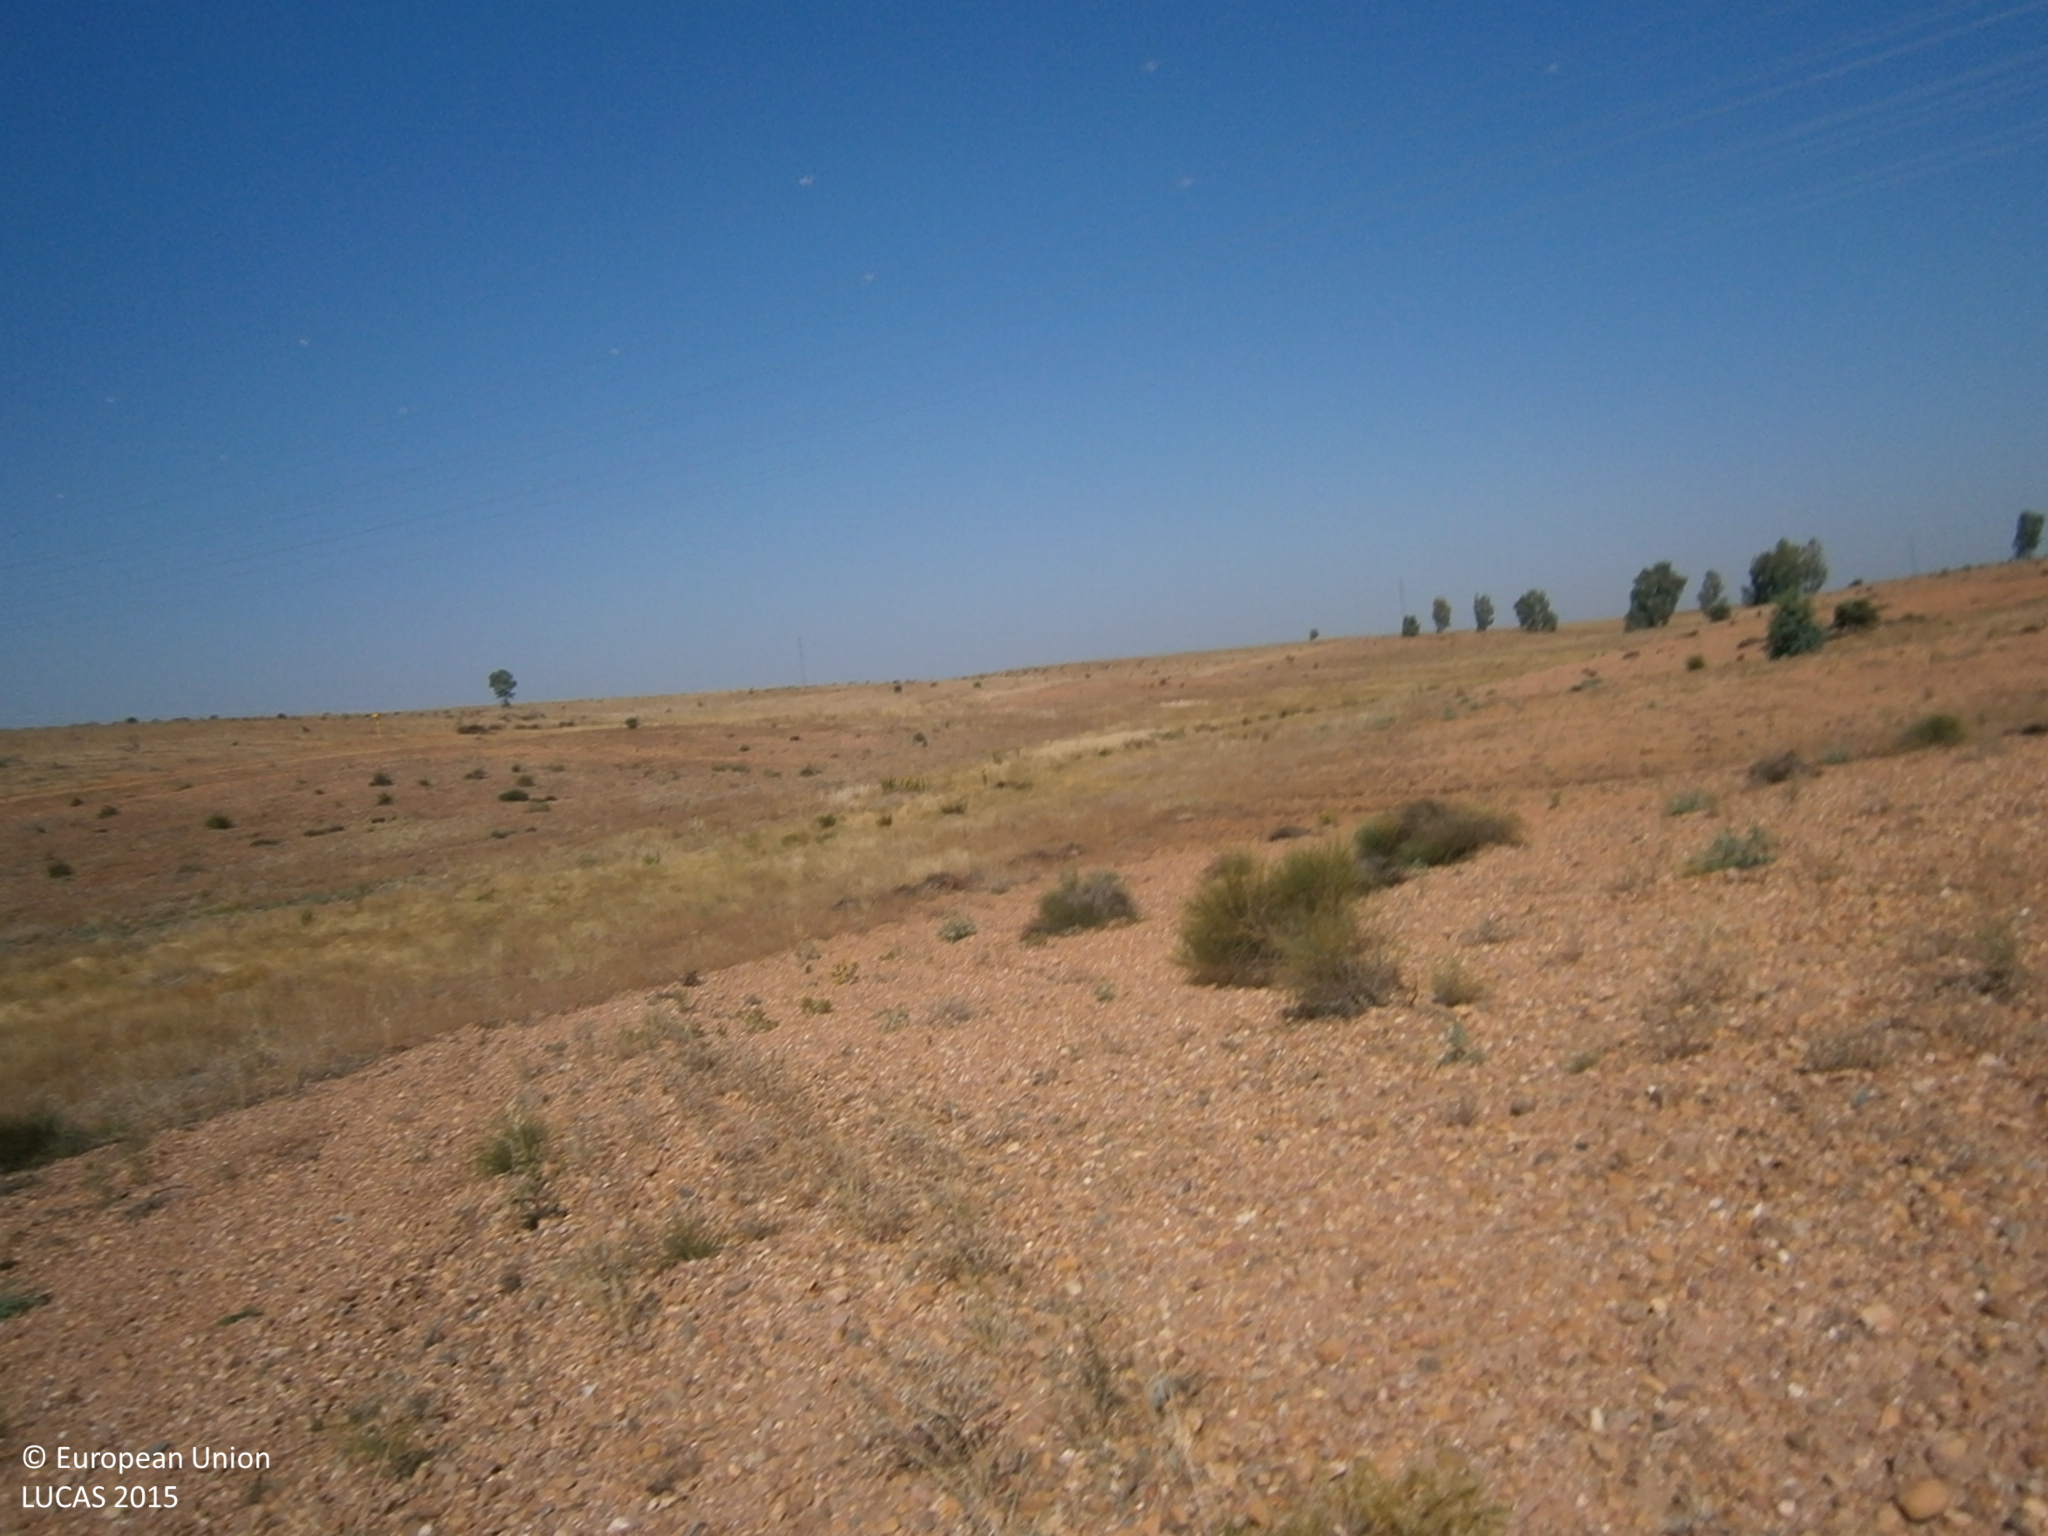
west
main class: Grassland
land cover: Spontaneously vegetated surfaces
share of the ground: 10 - 25 %
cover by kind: unconsolidated bare surface 85 %, herbaceous plants 15 %
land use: Fallow land
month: June
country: ES
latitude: 38.8427
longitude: -6.8060
